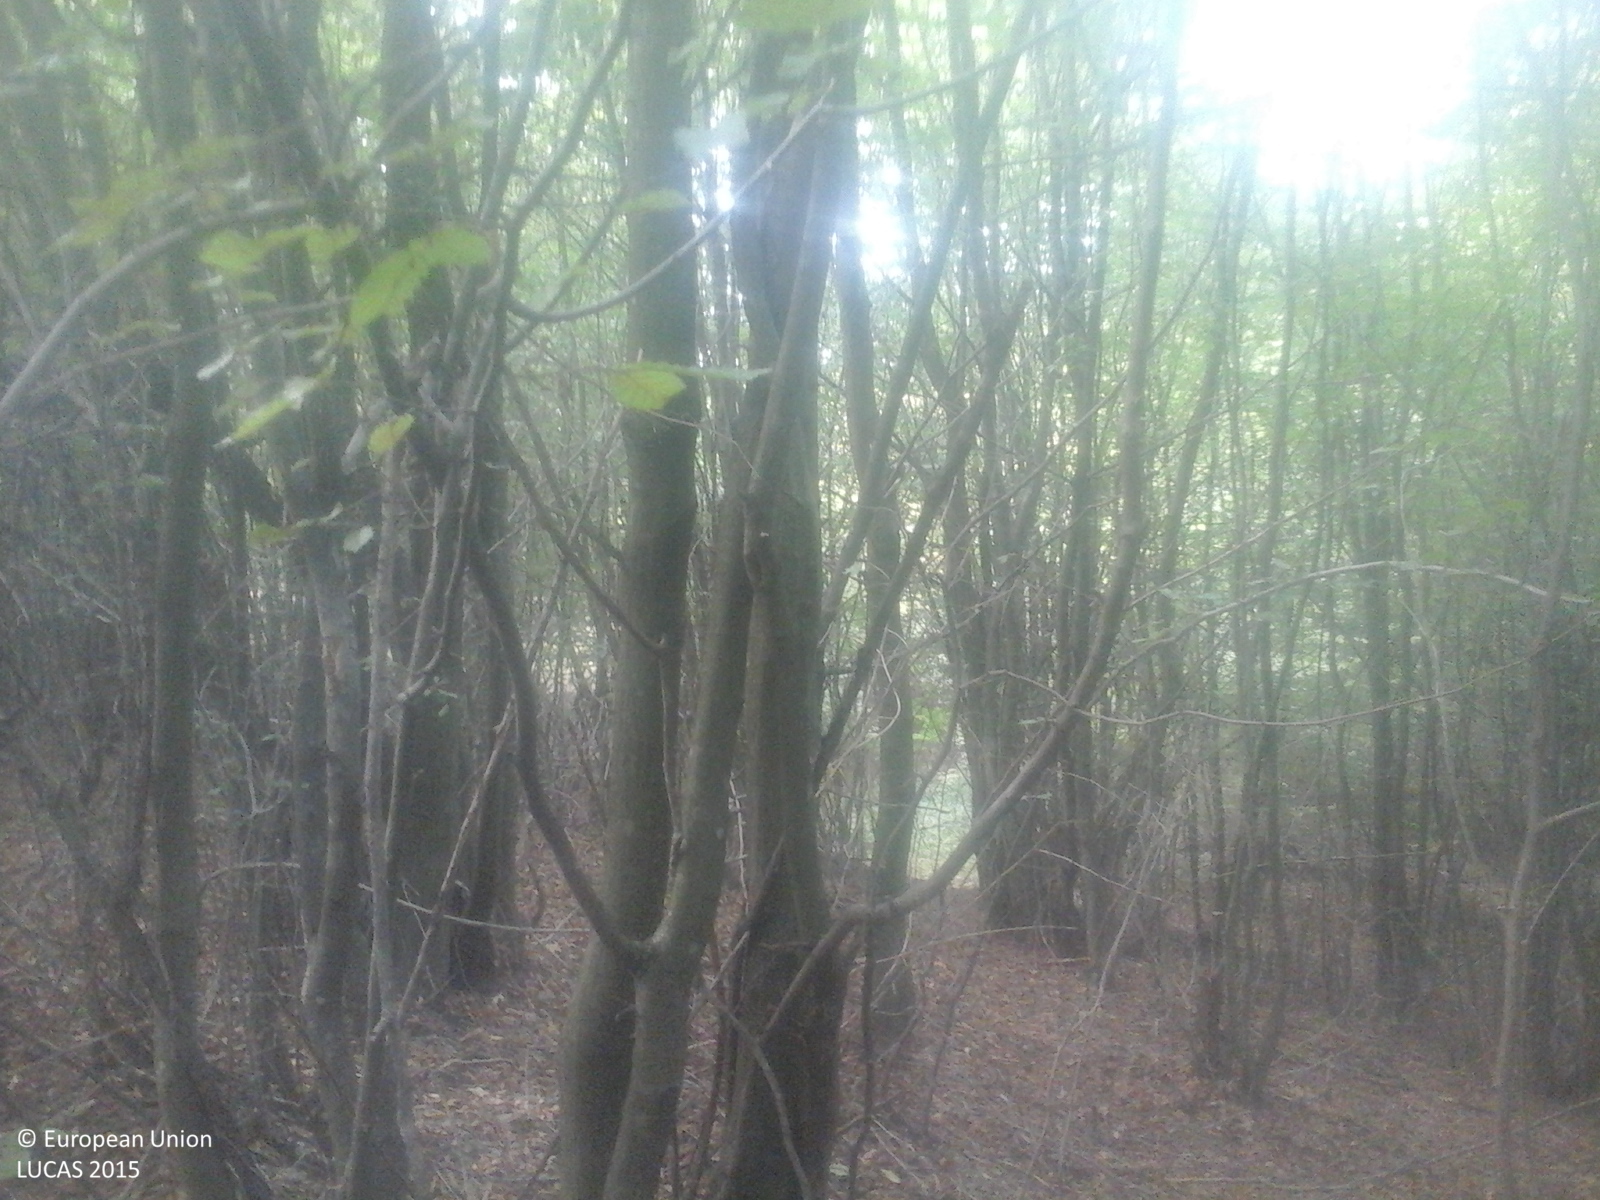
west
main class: Woodland
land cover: Broadleaved woodland
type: beech forest
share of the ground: > 75 %
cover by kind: broadleaved forest trees 100 %
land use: Forestry
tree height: > 5 m
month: September
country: RO
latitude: 47.1389
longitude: 23.1587
